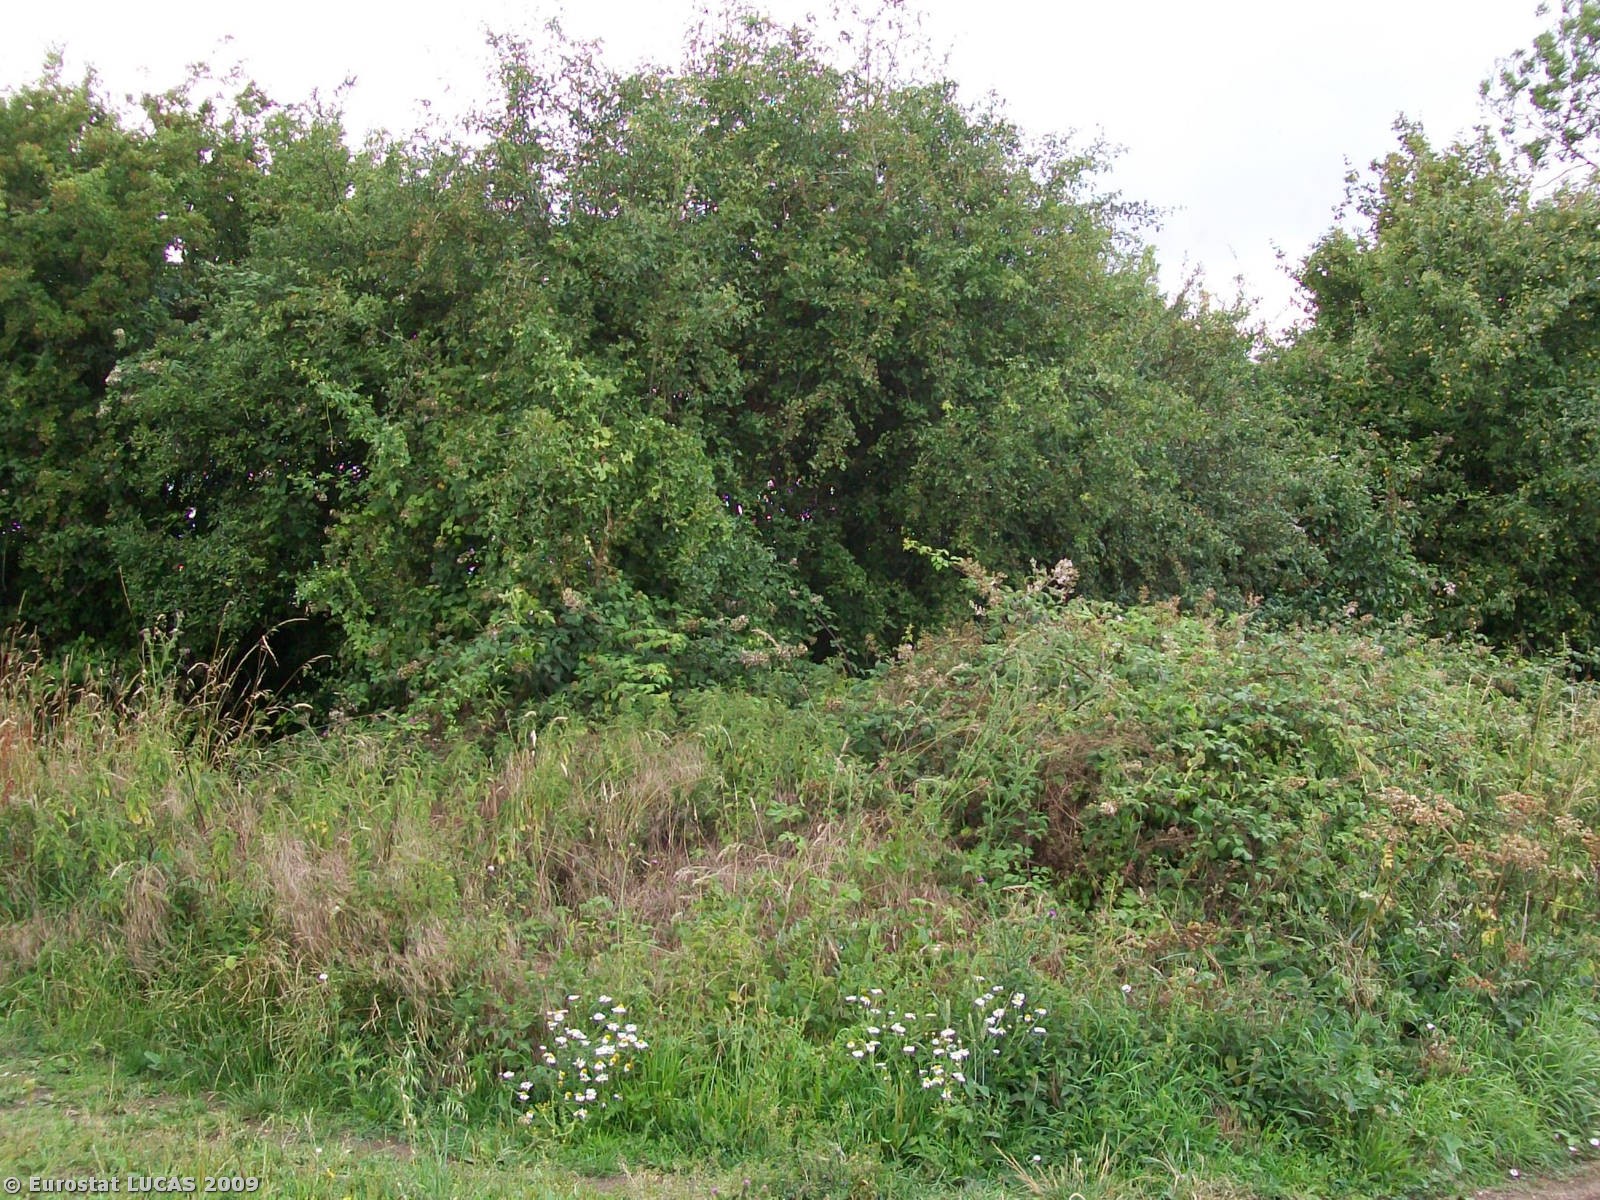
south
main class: Cropland
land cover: Common wheat
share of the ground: > 75 %
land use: Agriculture (excluding fallow land and kitchen gardens)
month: July
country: GB
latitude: 52.2460
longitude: 0.0227
